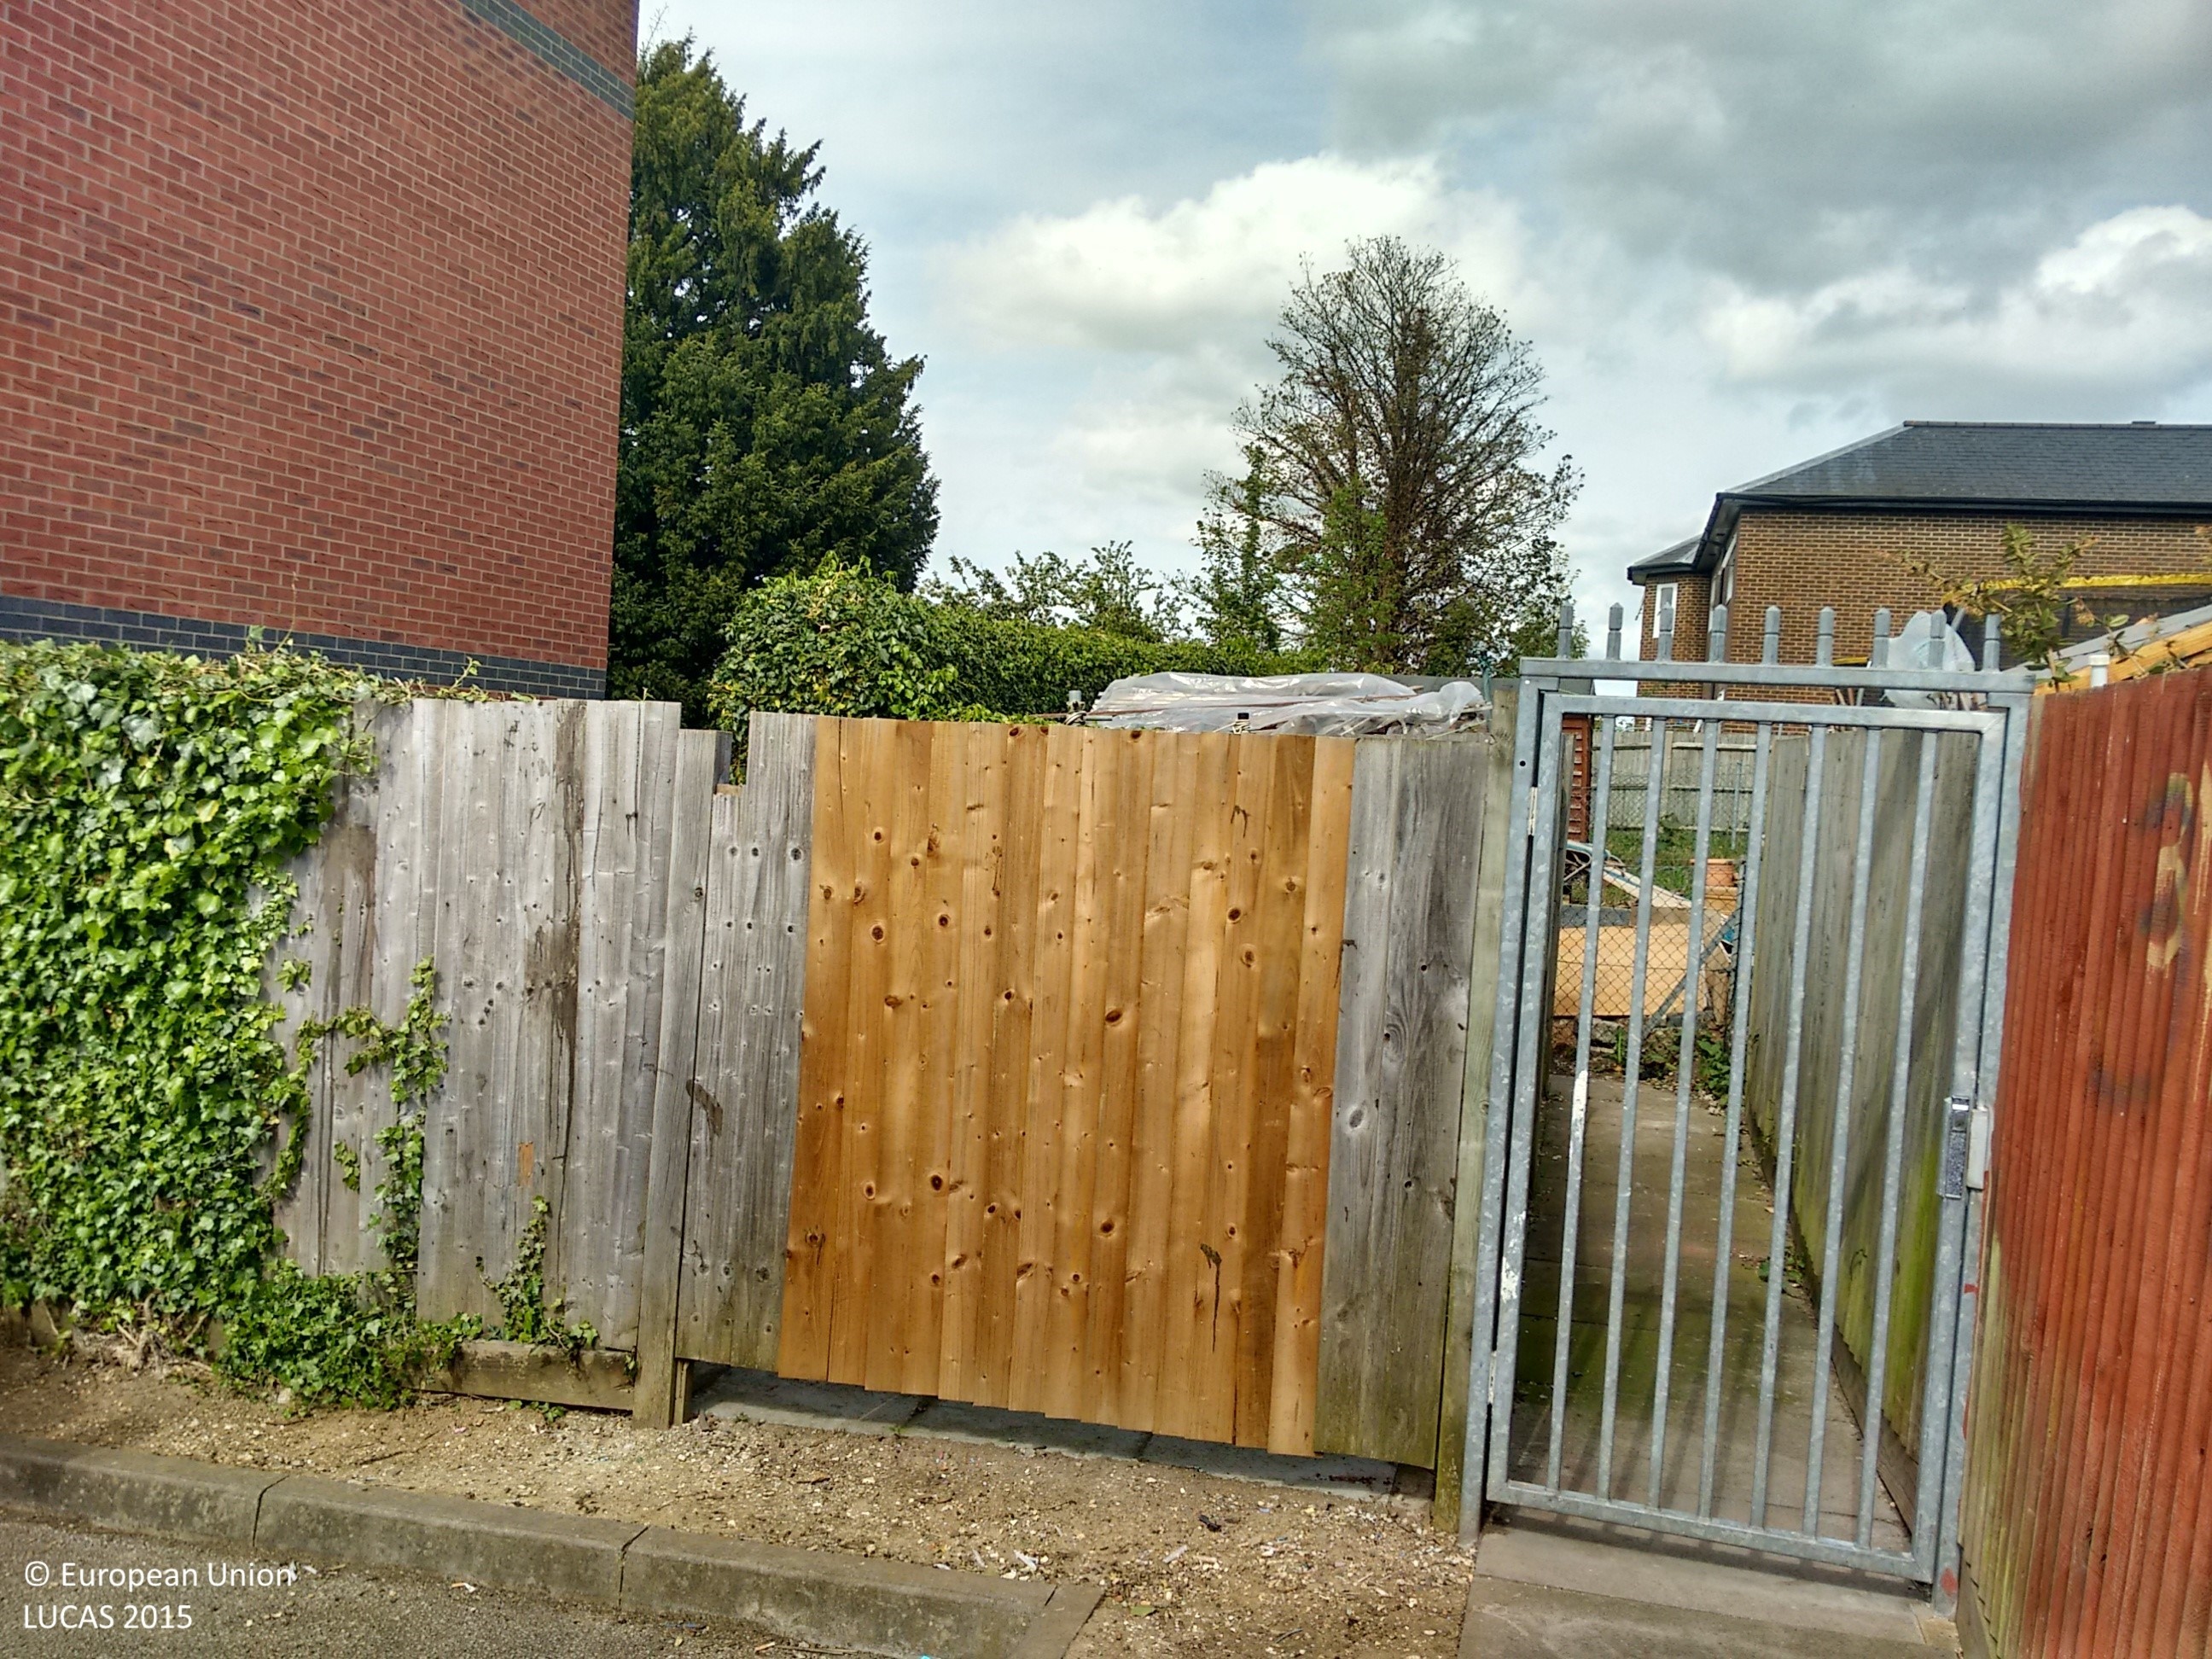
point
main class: Grassland
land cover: Grassland without tree/shrub cover
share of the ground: > 75 %
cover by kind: herbaceous plants 80 %, consolidated bare surface 20 %
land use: Residential
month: May
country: GB
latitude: 51.8810
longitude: -0.4244
